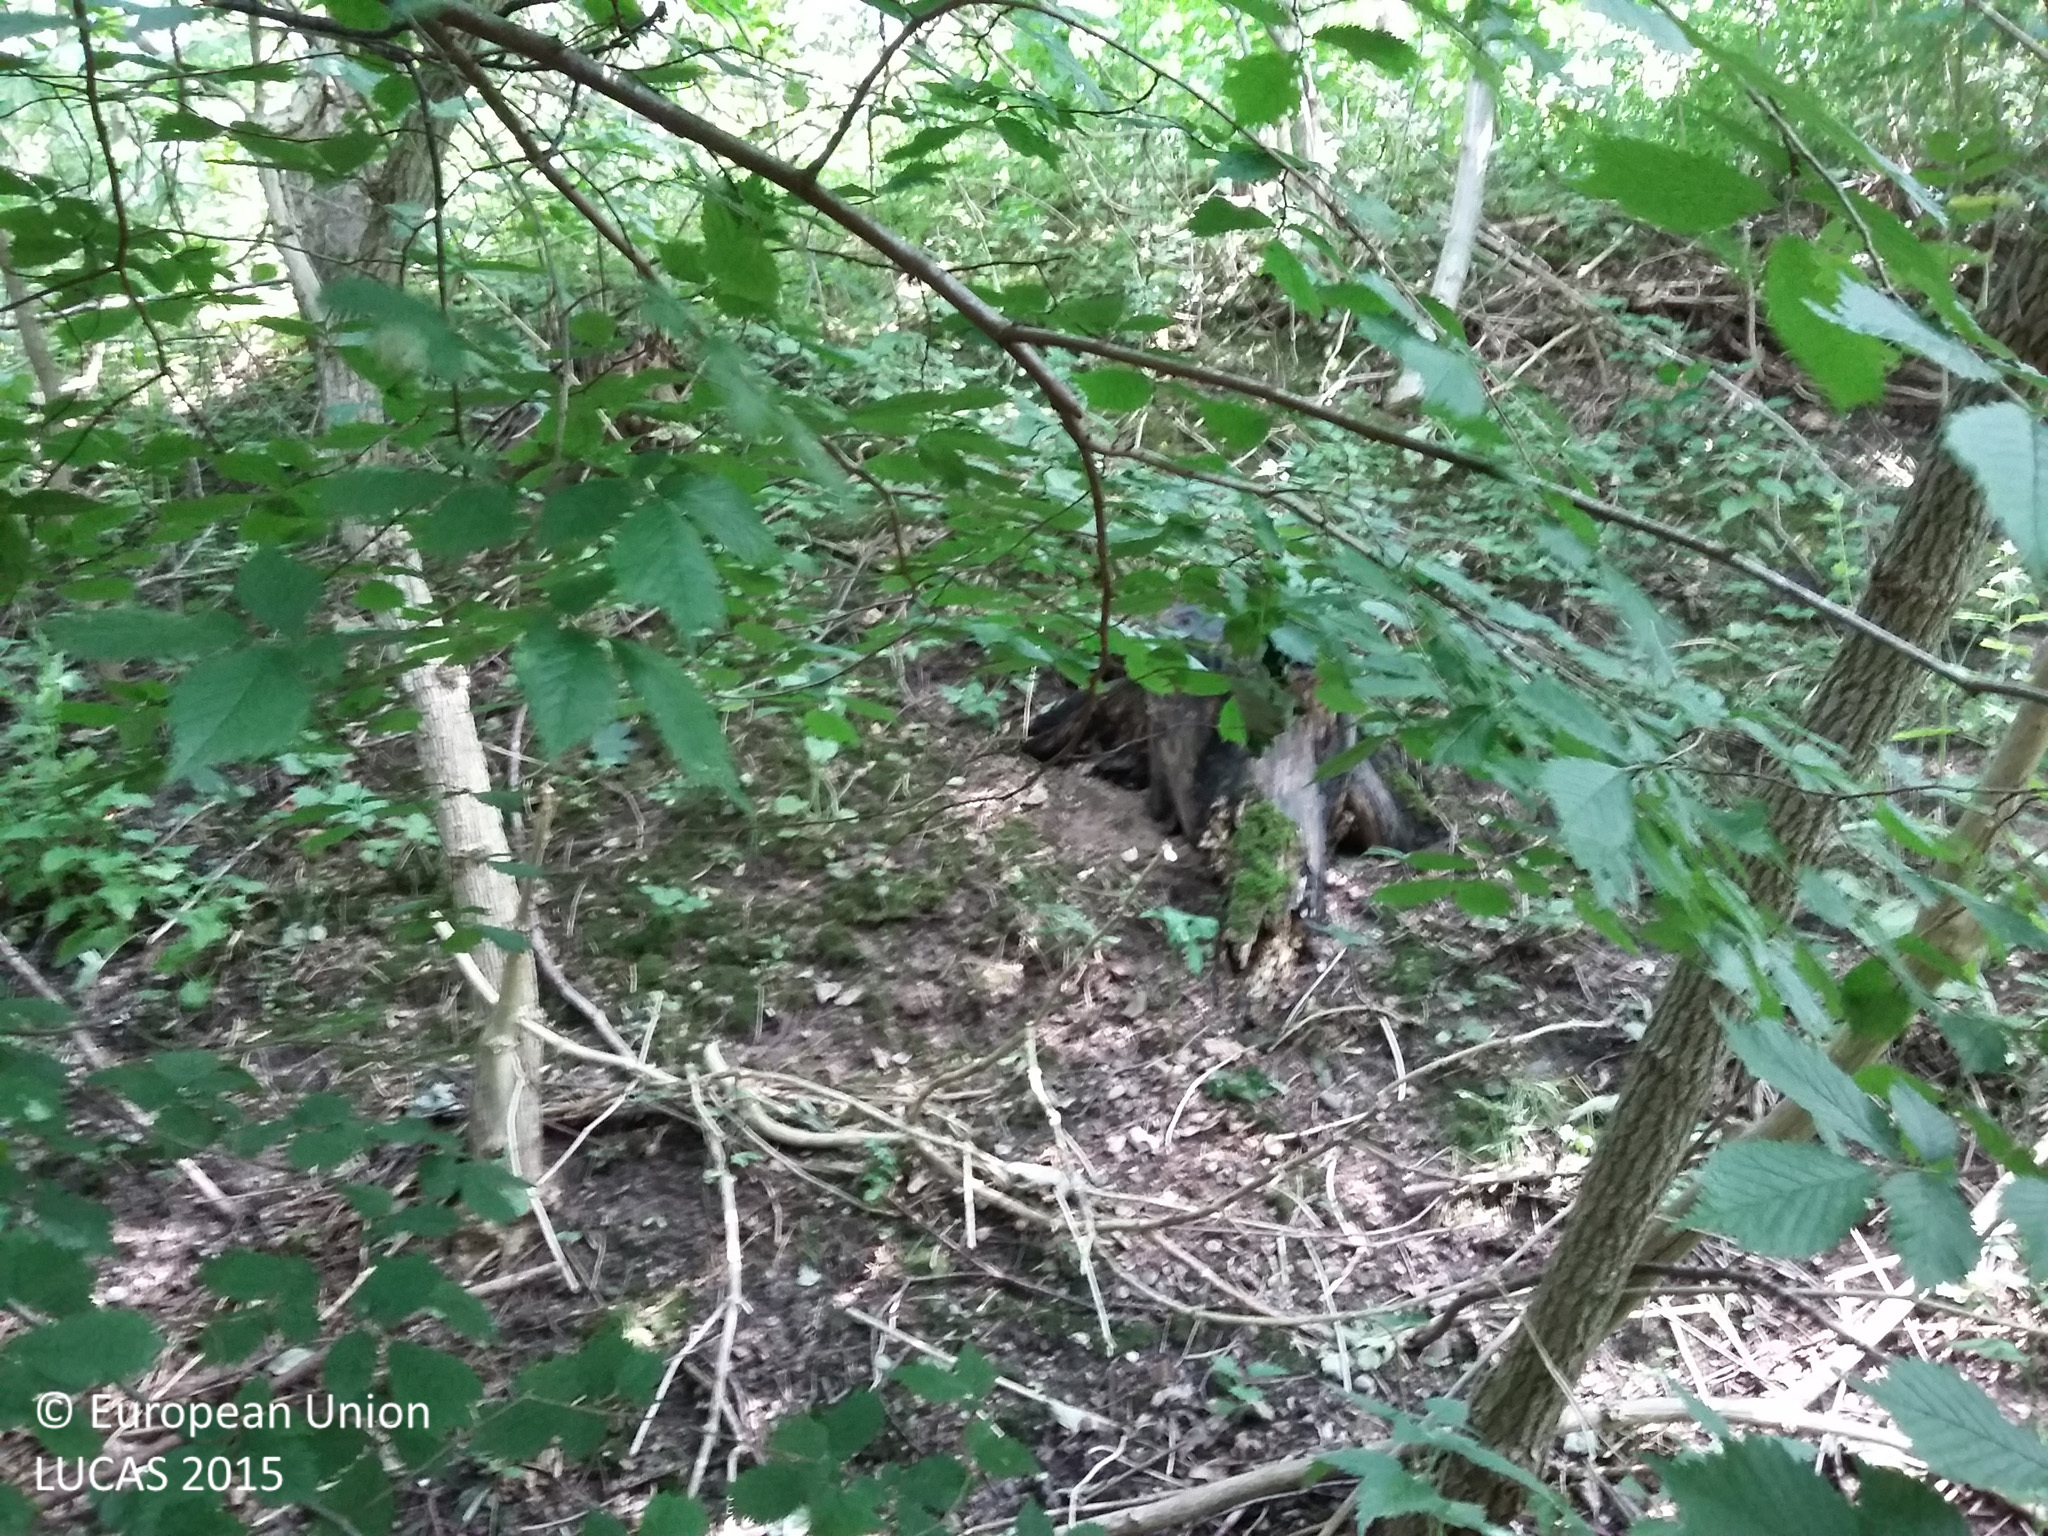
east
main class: Woodland
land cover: Broadleaved woodland
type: beech forest
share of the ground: > 75 %
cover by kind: broadleaved forest trees 80 %, herbaceous plants 15 %, shrubs 5 %
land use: Semi-natural and natural areas not in use
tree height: > 5 m
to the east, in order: Broadleaved woodland; Ditches and canals; Broadleaved woodland; Grass margins; Paved roads, cycling and walking lanes; Grass margins; Spruce dominated coniferous woodland; Grass margins; Tracks; Grass margins; Other mixed woodland
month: July
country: DK
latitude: 55.4954
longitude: 11.5341
